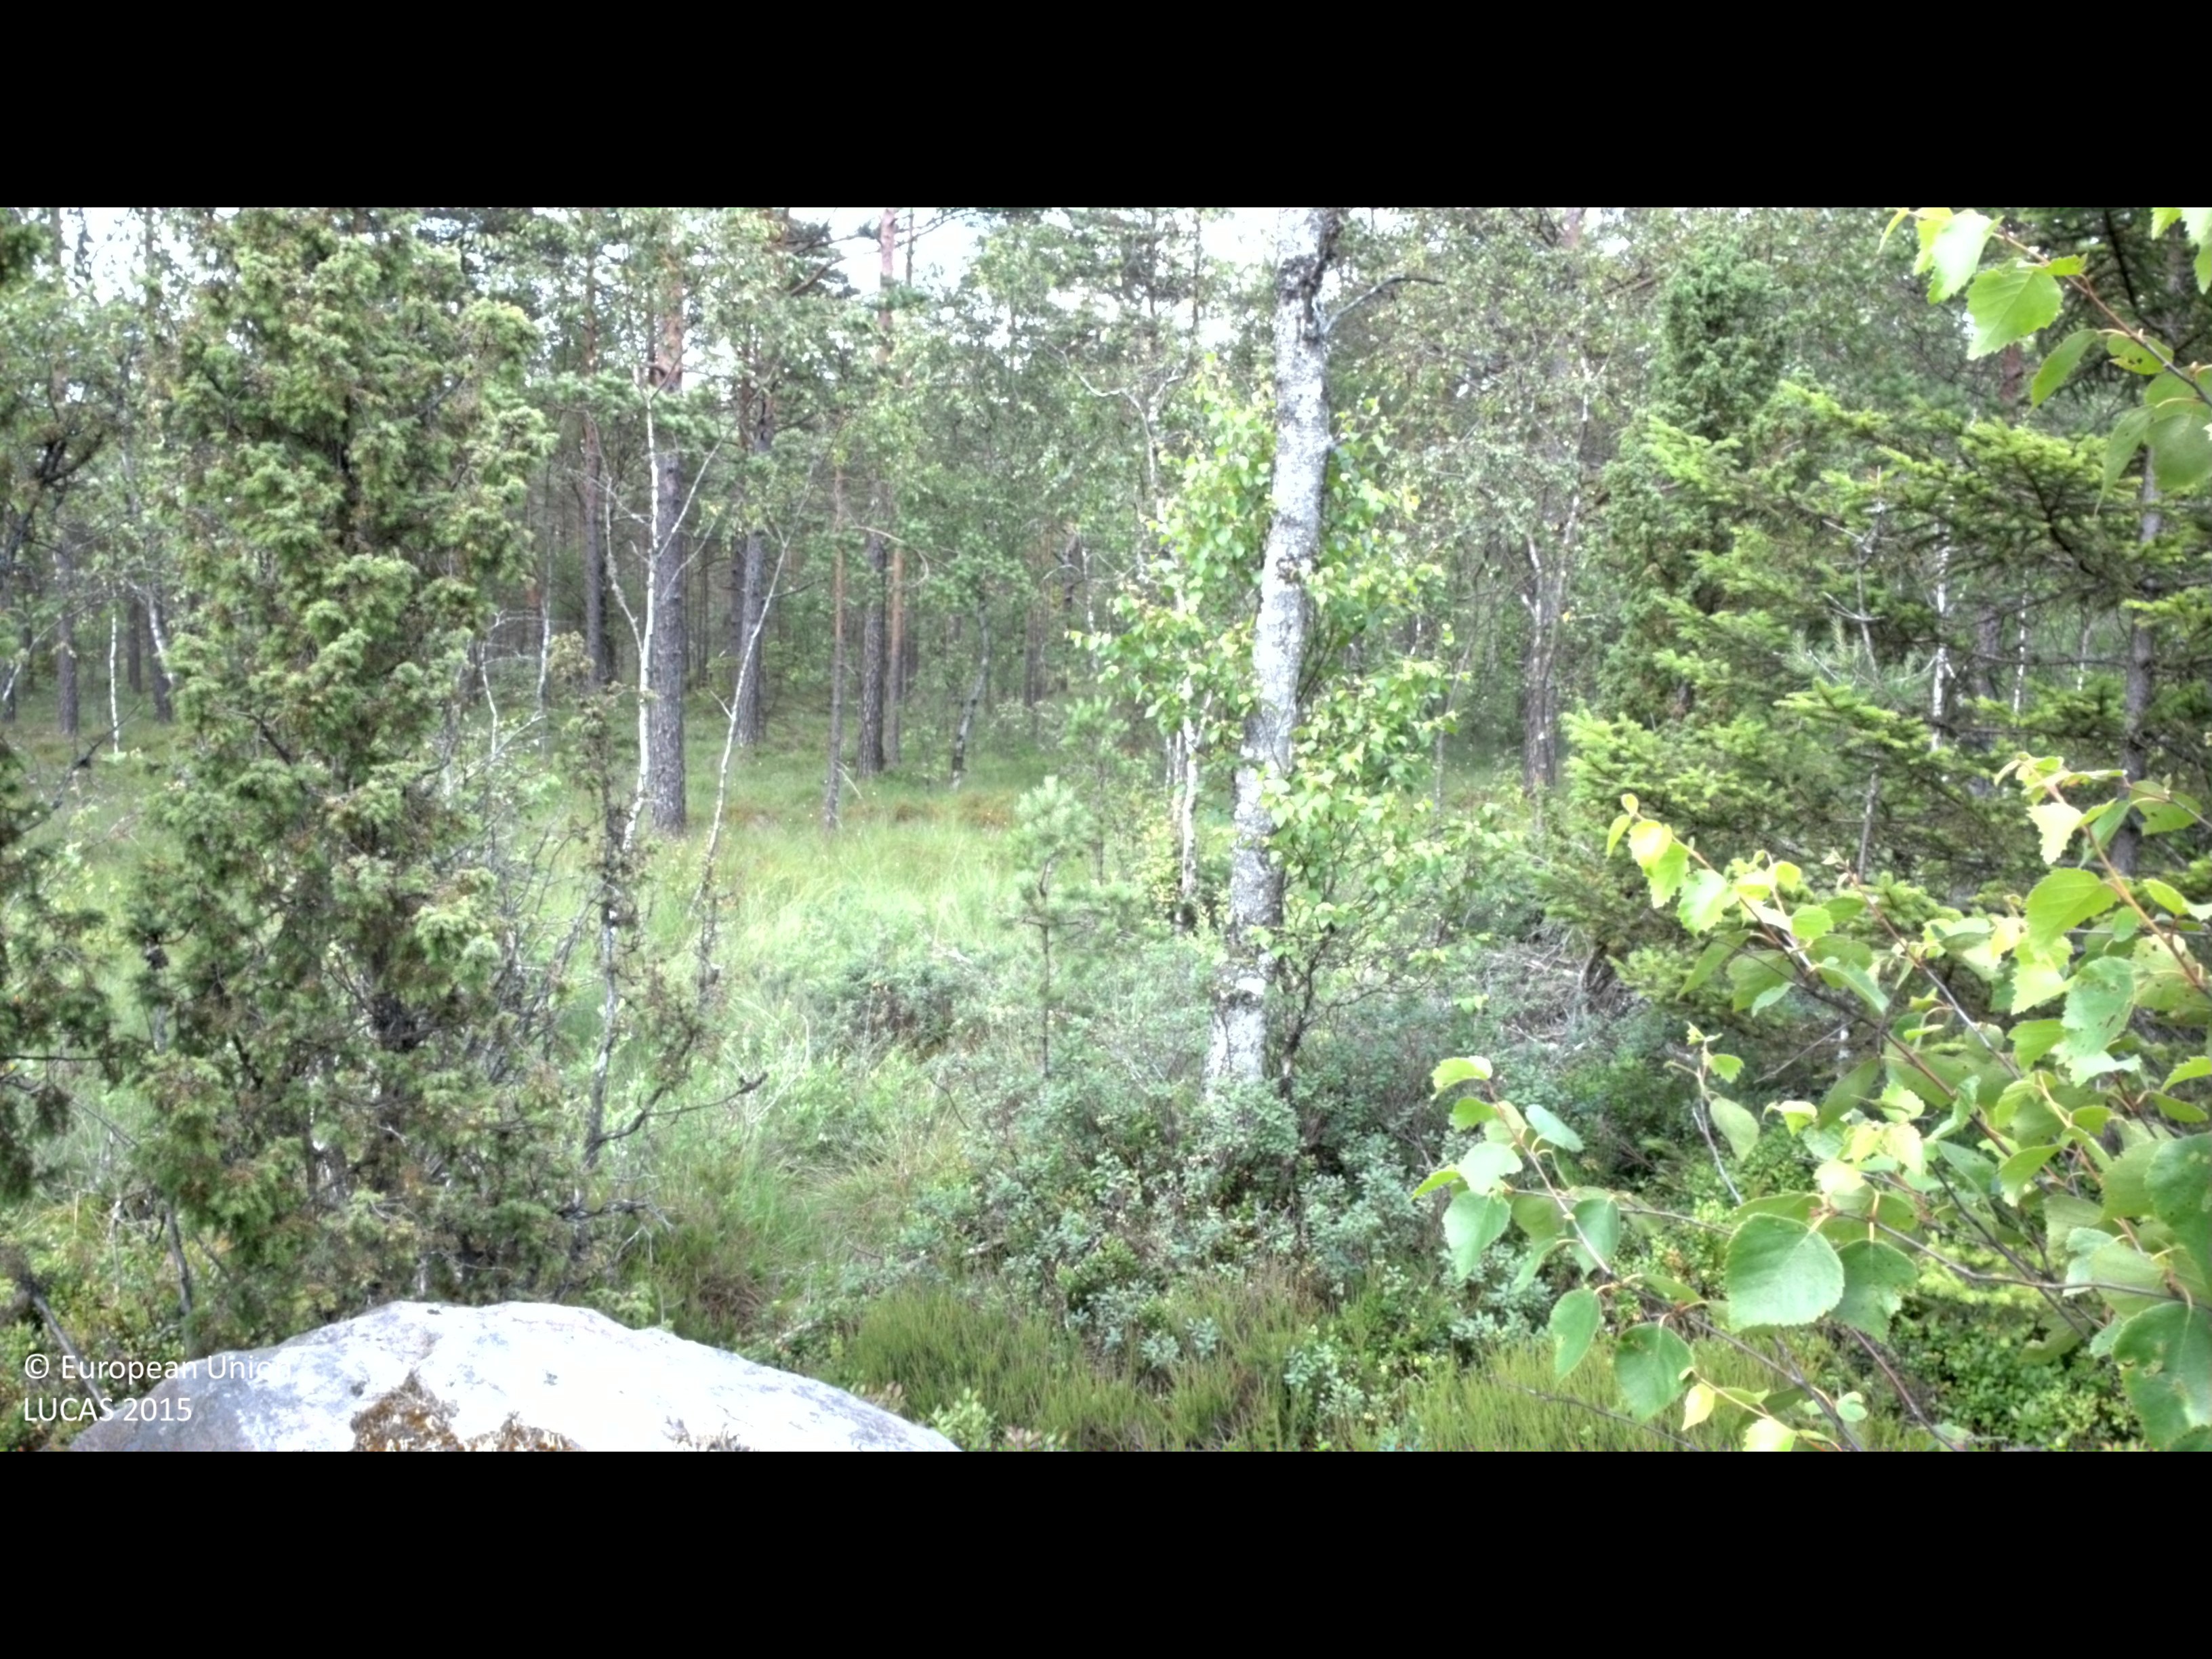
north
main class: Woodland
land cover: Pine dominated mixed woodland
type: boreal forest
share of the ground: 25 - 50 %
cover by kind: shrubs 35 %, coniferous forest trees 30 %, broadleaved forest trees 20 %, herbaceous plants 15 %
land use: Forestry
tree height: > 5 m
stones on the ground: 25 - 50 %
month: July
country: SE
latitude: 56.5289
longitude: 13.7525
